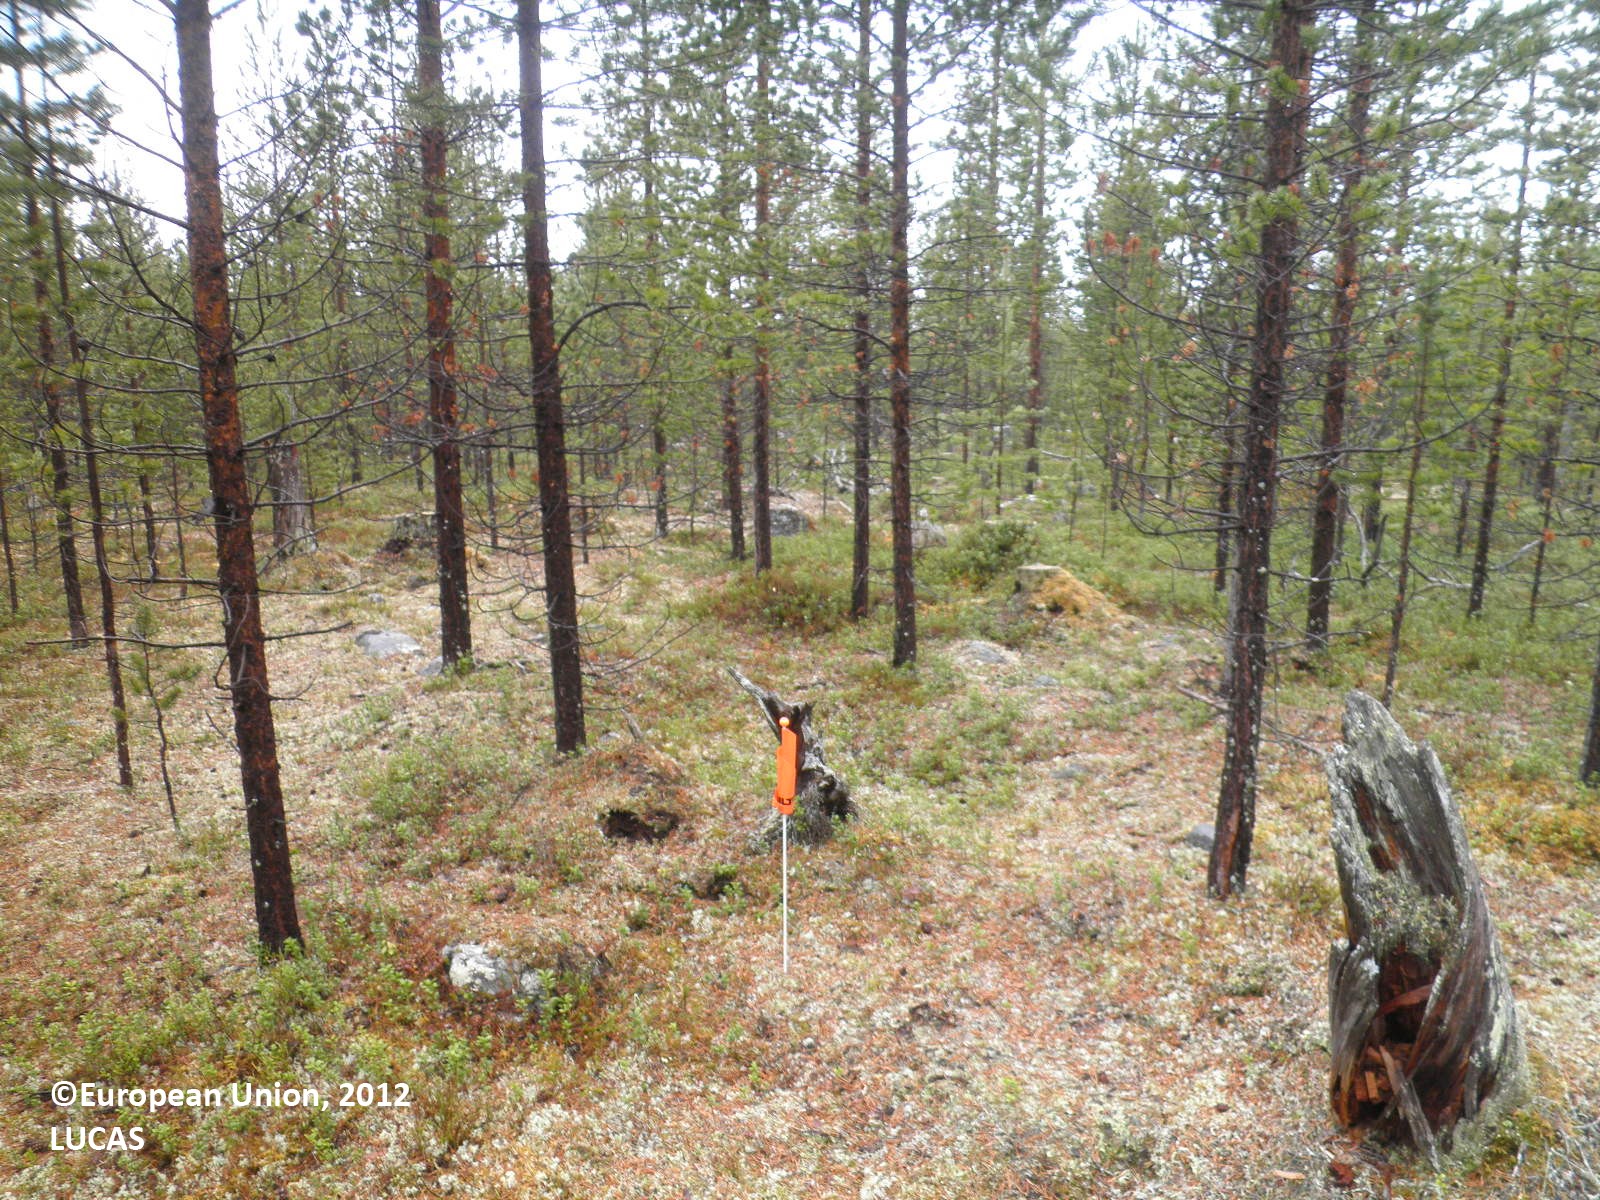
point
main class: Woodland
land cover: Pine dominated coniferous woodland
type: boreal forest
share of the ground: 50 - 75 %
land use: Forestry
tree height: > 5 m
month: June
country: FI
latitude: 68.8978
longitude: 26.7534
